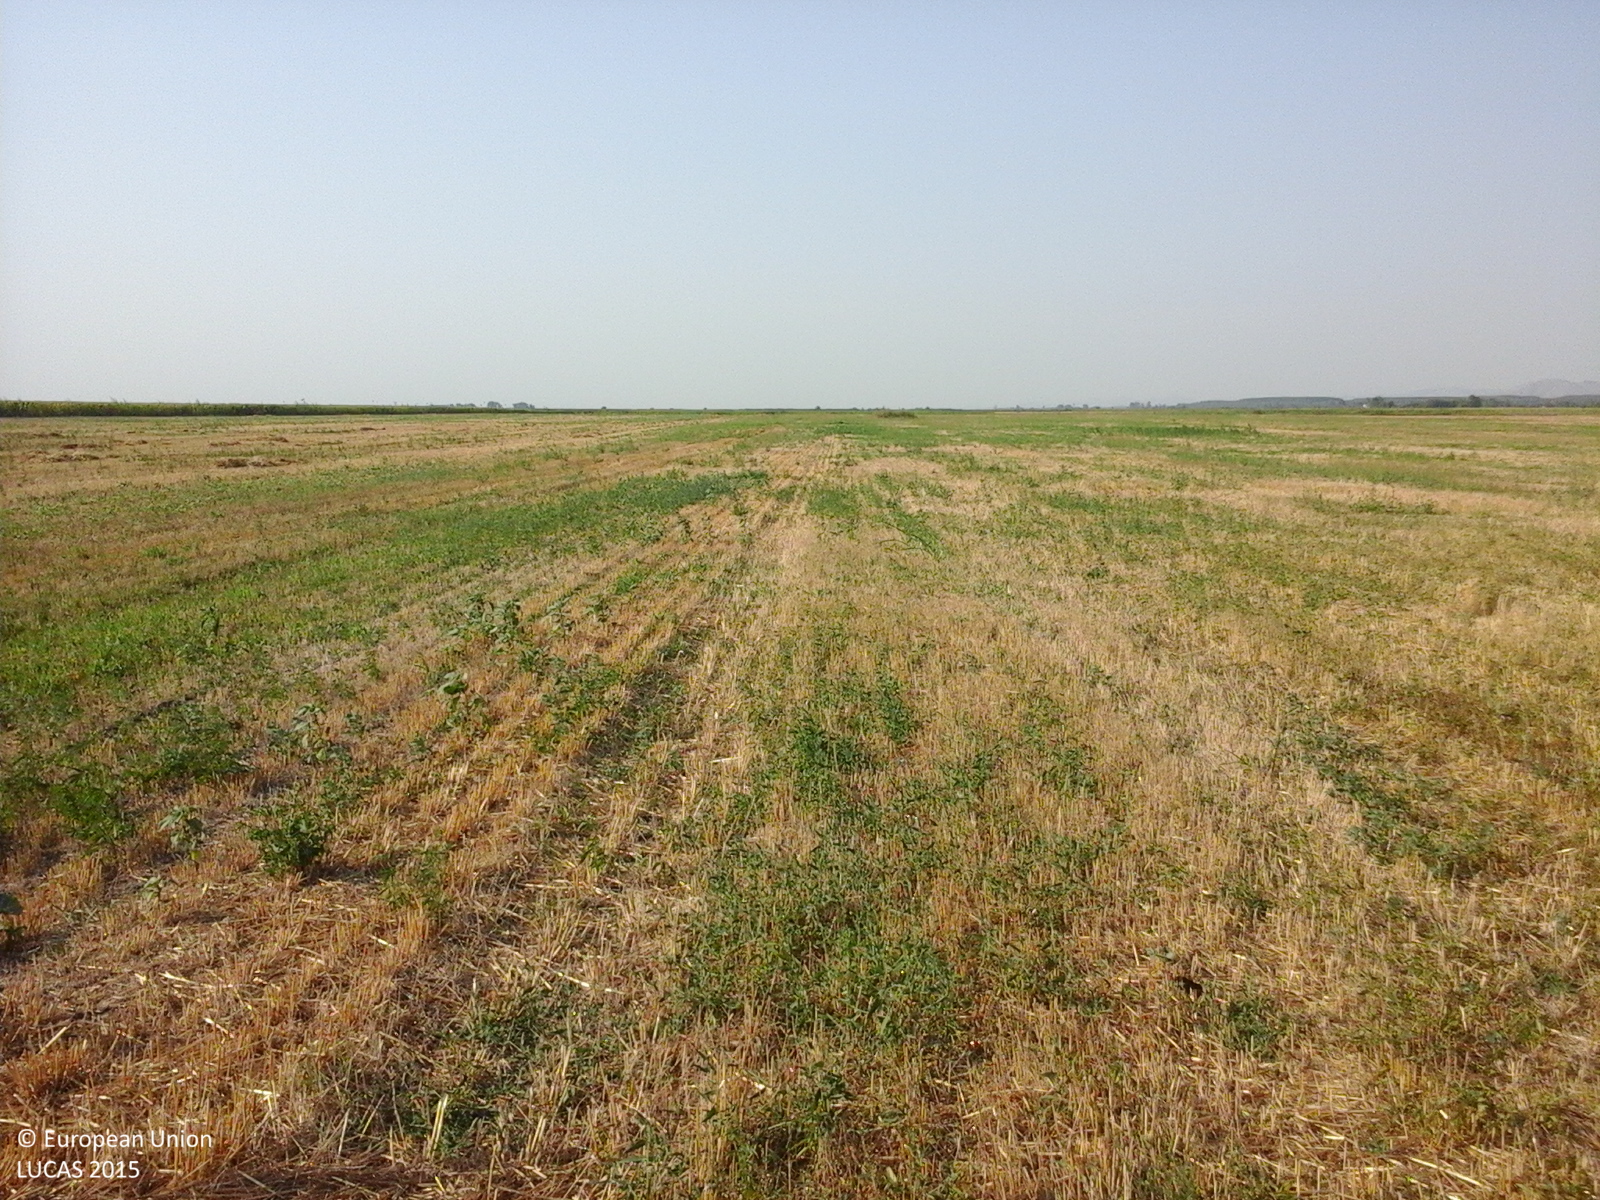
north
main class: Cropland
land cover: Barley
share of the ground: 50 - 75 %
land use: Agriculture (excluding fallow land and kitchen gardens)
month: August
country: RO
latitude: 44.9731
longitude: 28.1088
